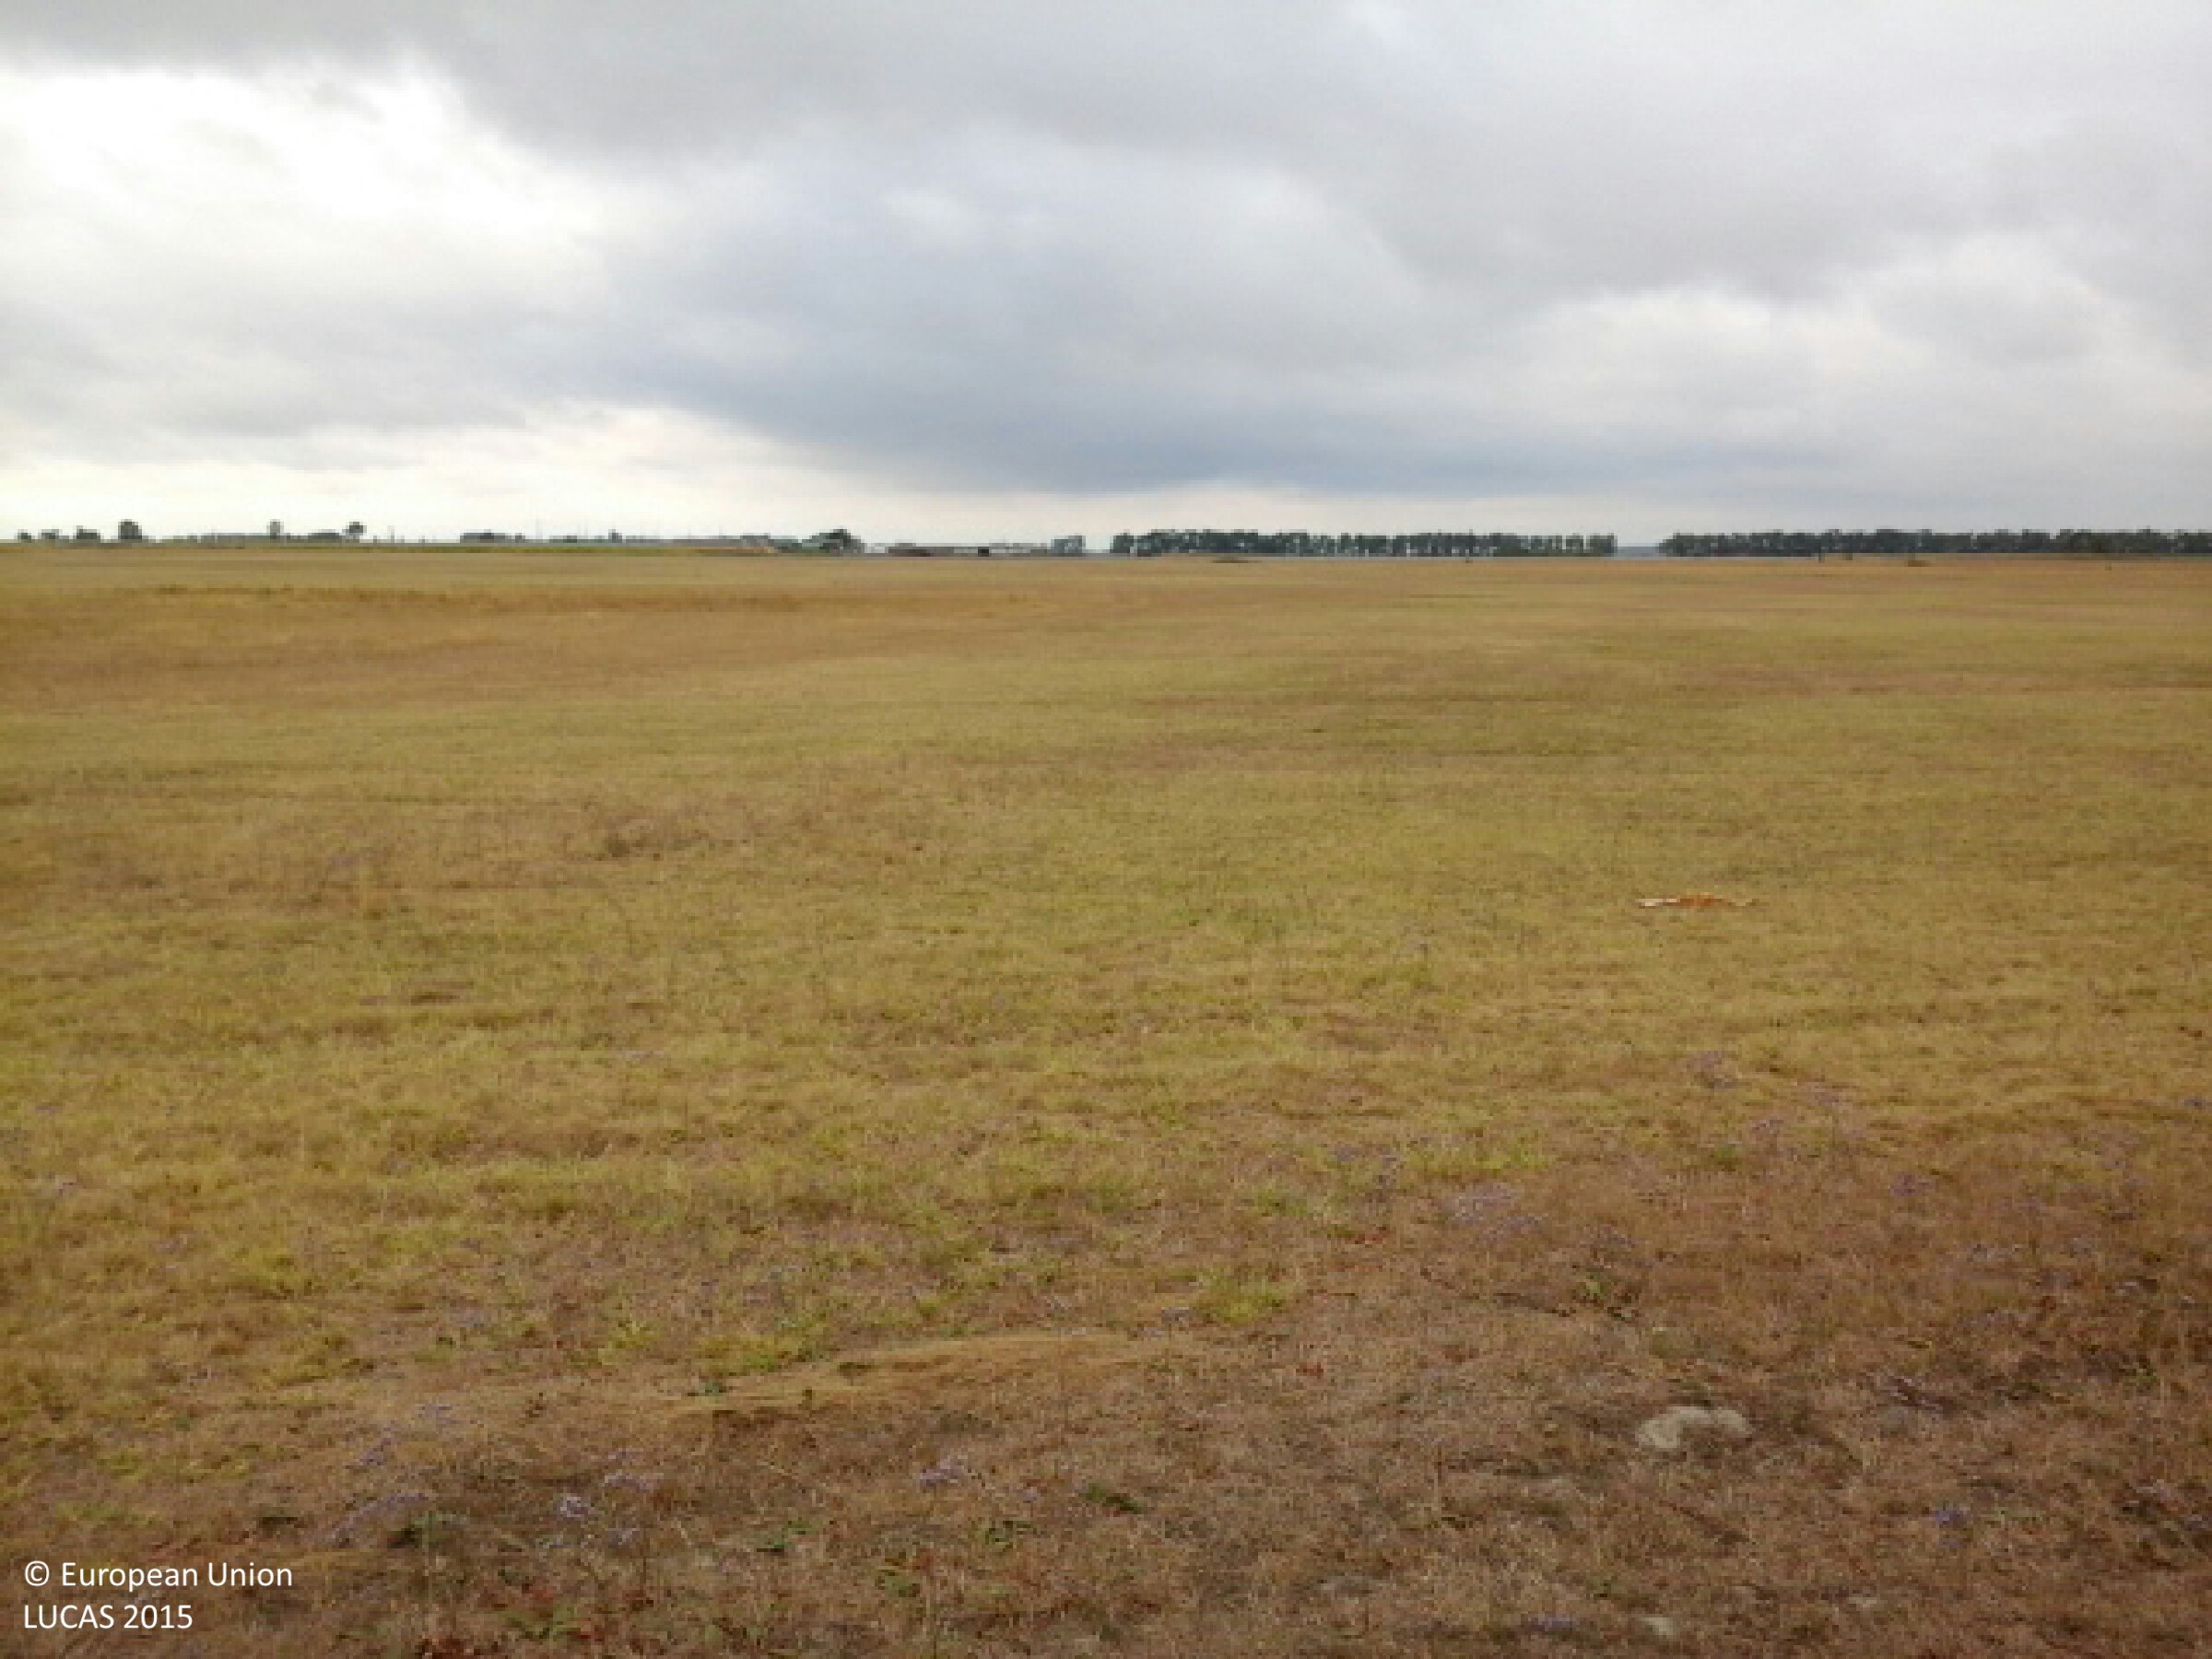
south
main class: Grassland
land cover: Grassland without tree/shrub cover
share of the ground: > 75 %
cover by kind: herbaceous plants 100 %
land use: Agriculture (excluding fallow land and kitchen gardens)
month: August
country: HU
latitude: 47.1412
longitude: 21.5530
